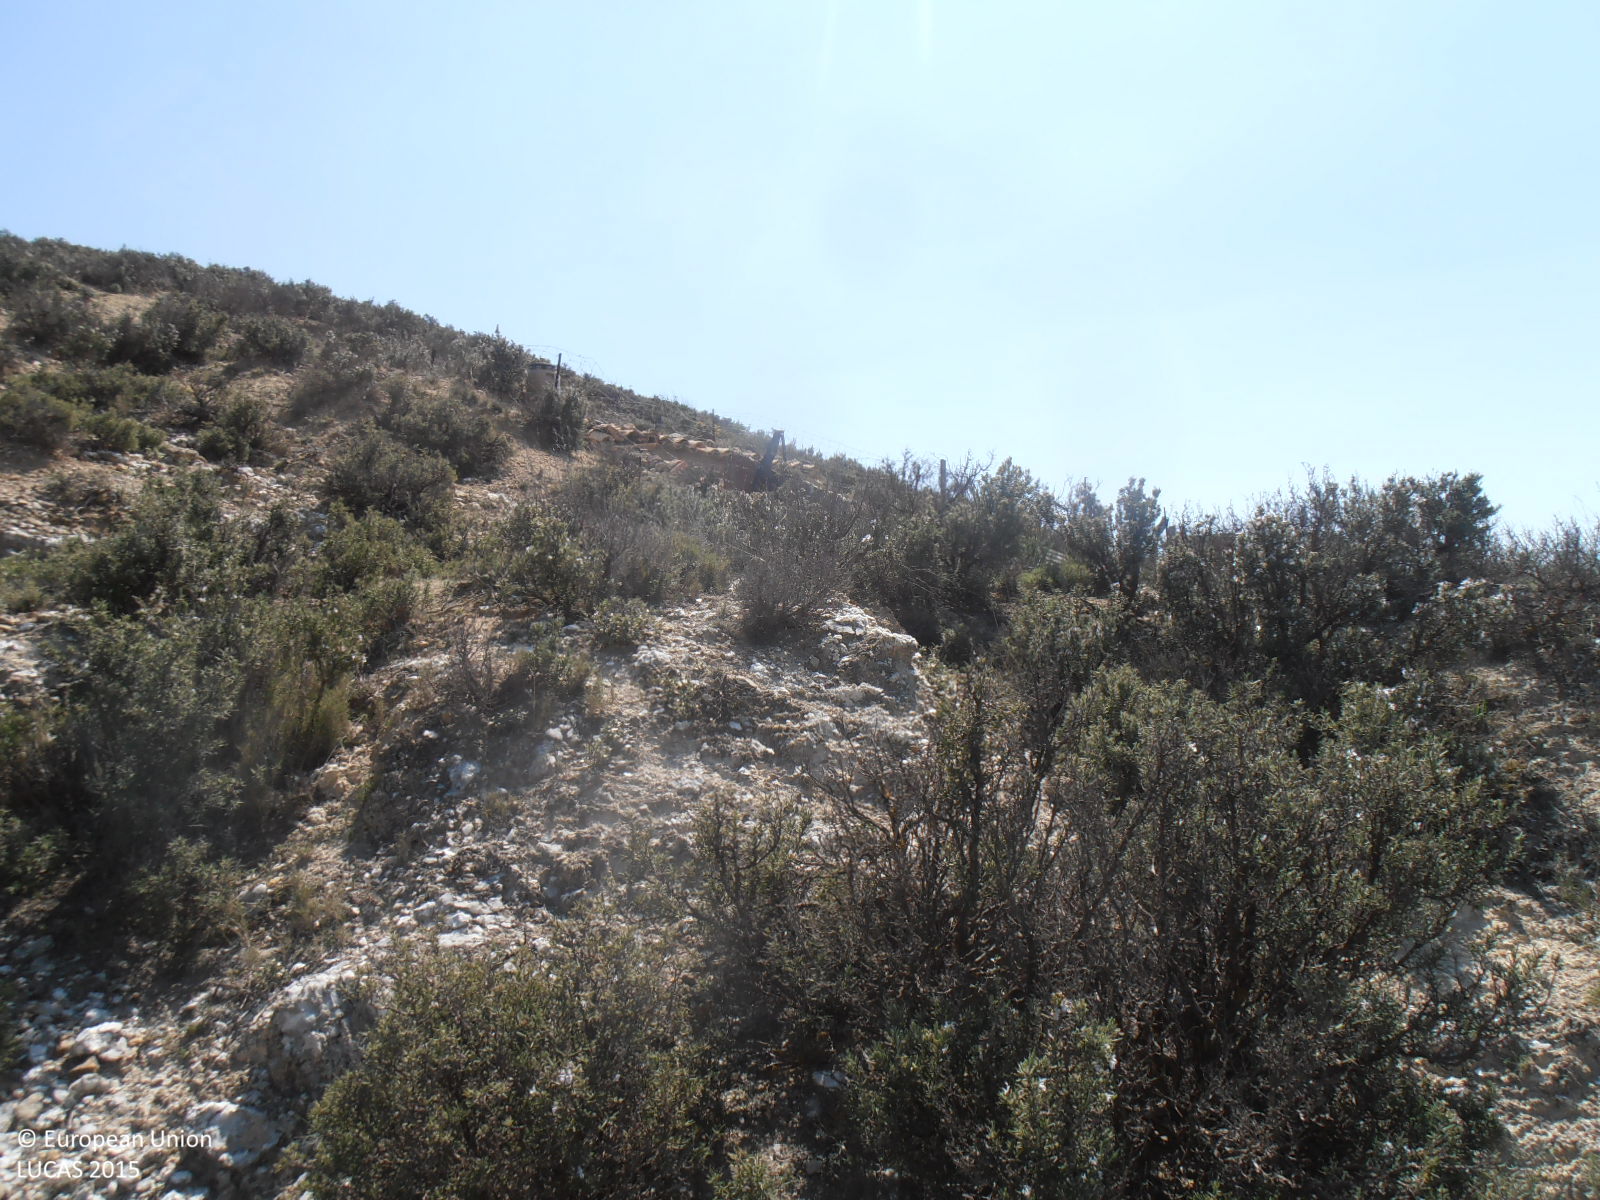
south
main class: Shrubland
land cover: Shrubland without tree cover
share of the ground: > 75 %
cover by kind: shrubs 60 %, consolidated bare surface 40 %
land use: Semi-natural and natural areas not in use
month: April
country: ES
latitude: 41.6029
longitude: -0.9525
